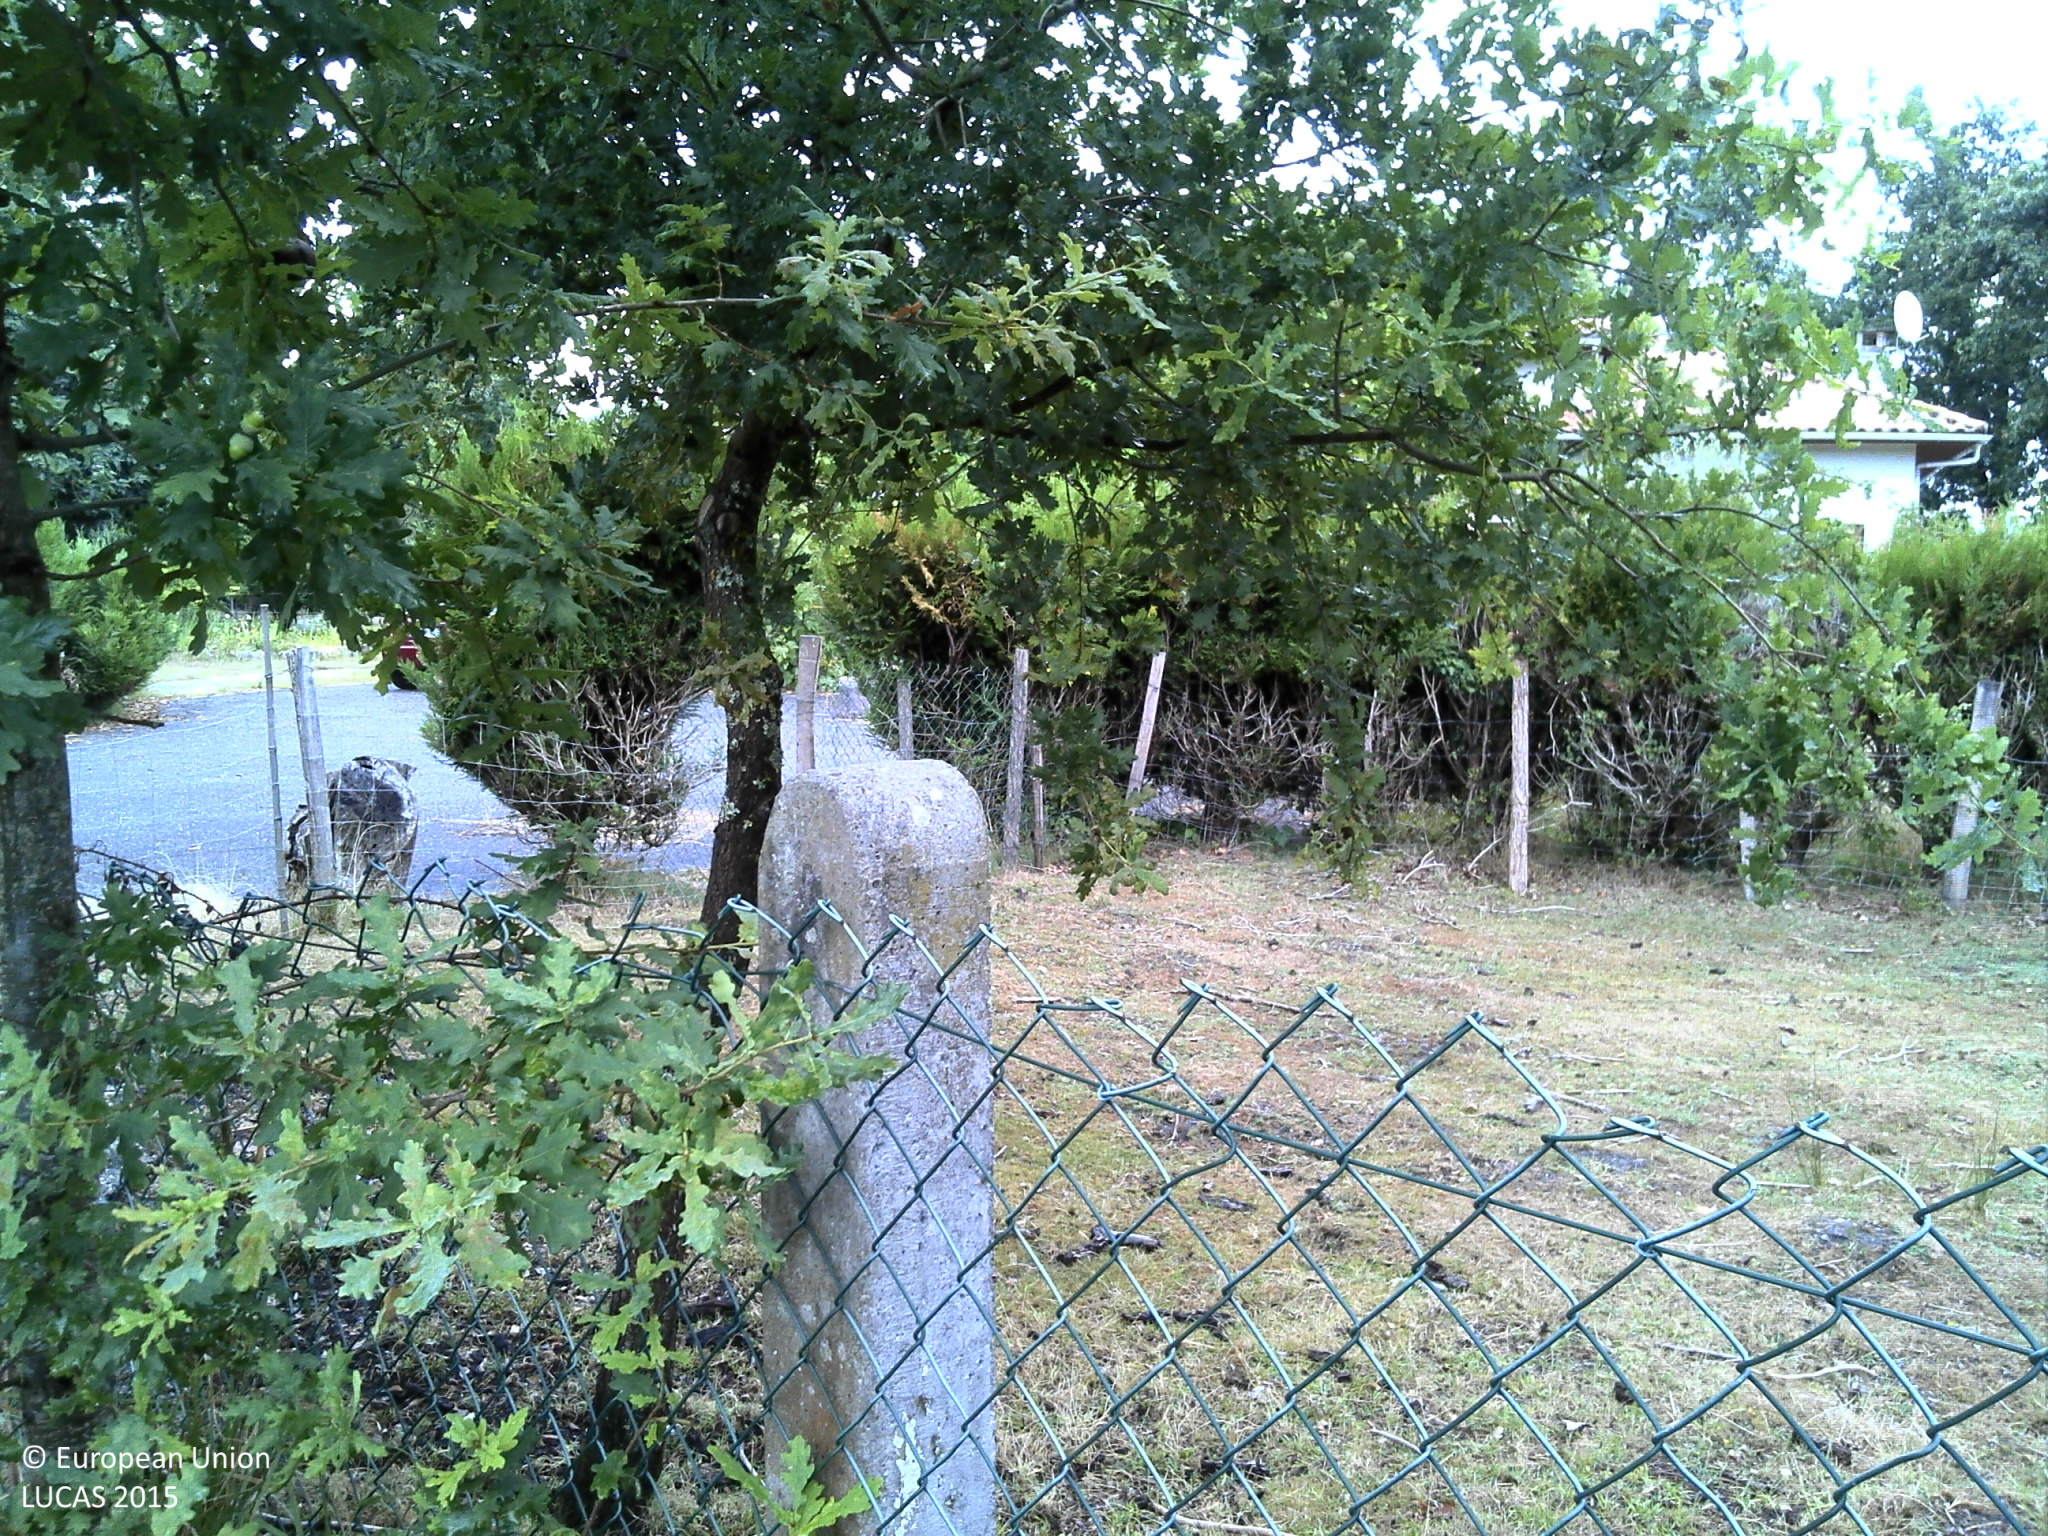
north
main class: Grassland
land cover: Grassland without tree/shrub cover
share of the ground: > 75 %
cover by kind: herbaceous plants 100 %
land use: Residential
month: July
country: FR
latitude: 44.7546
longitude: -0.7442
